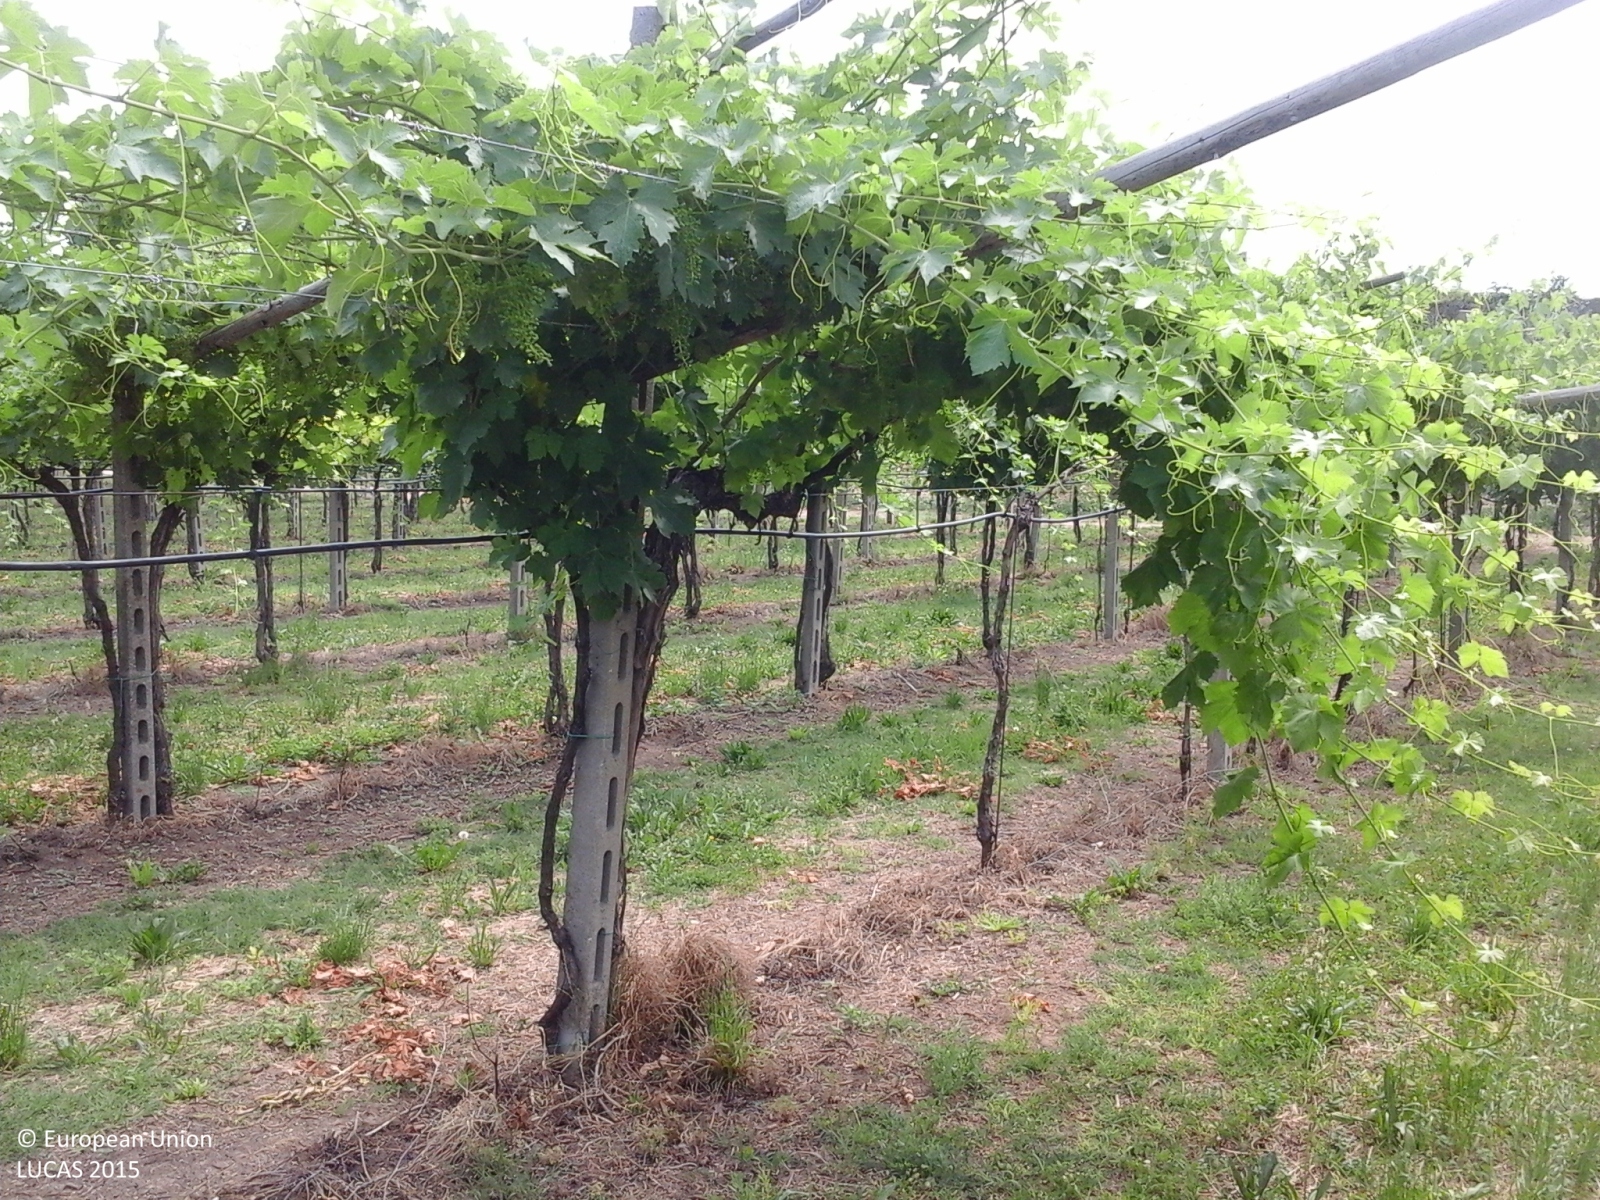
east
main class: Cropland
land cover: Vineyards
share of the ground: 50 - 75 %
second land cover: Grassland without tree/shrub cover
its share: > 75 %
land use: Agriculture (excluding fallow land and kitchen gardens)
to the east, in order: Vineyards; Grassland without tree/shrub cover; Vineyards; Inland fresh running water; Olive groves; Vineyards; Olive groves; Artificial constructions; Grassland without tree/shrub cover; Vineyards; Grassland without tree/shrub cover; Vineyards
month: June
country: IT
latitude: 45.5368
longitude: 10.8821
